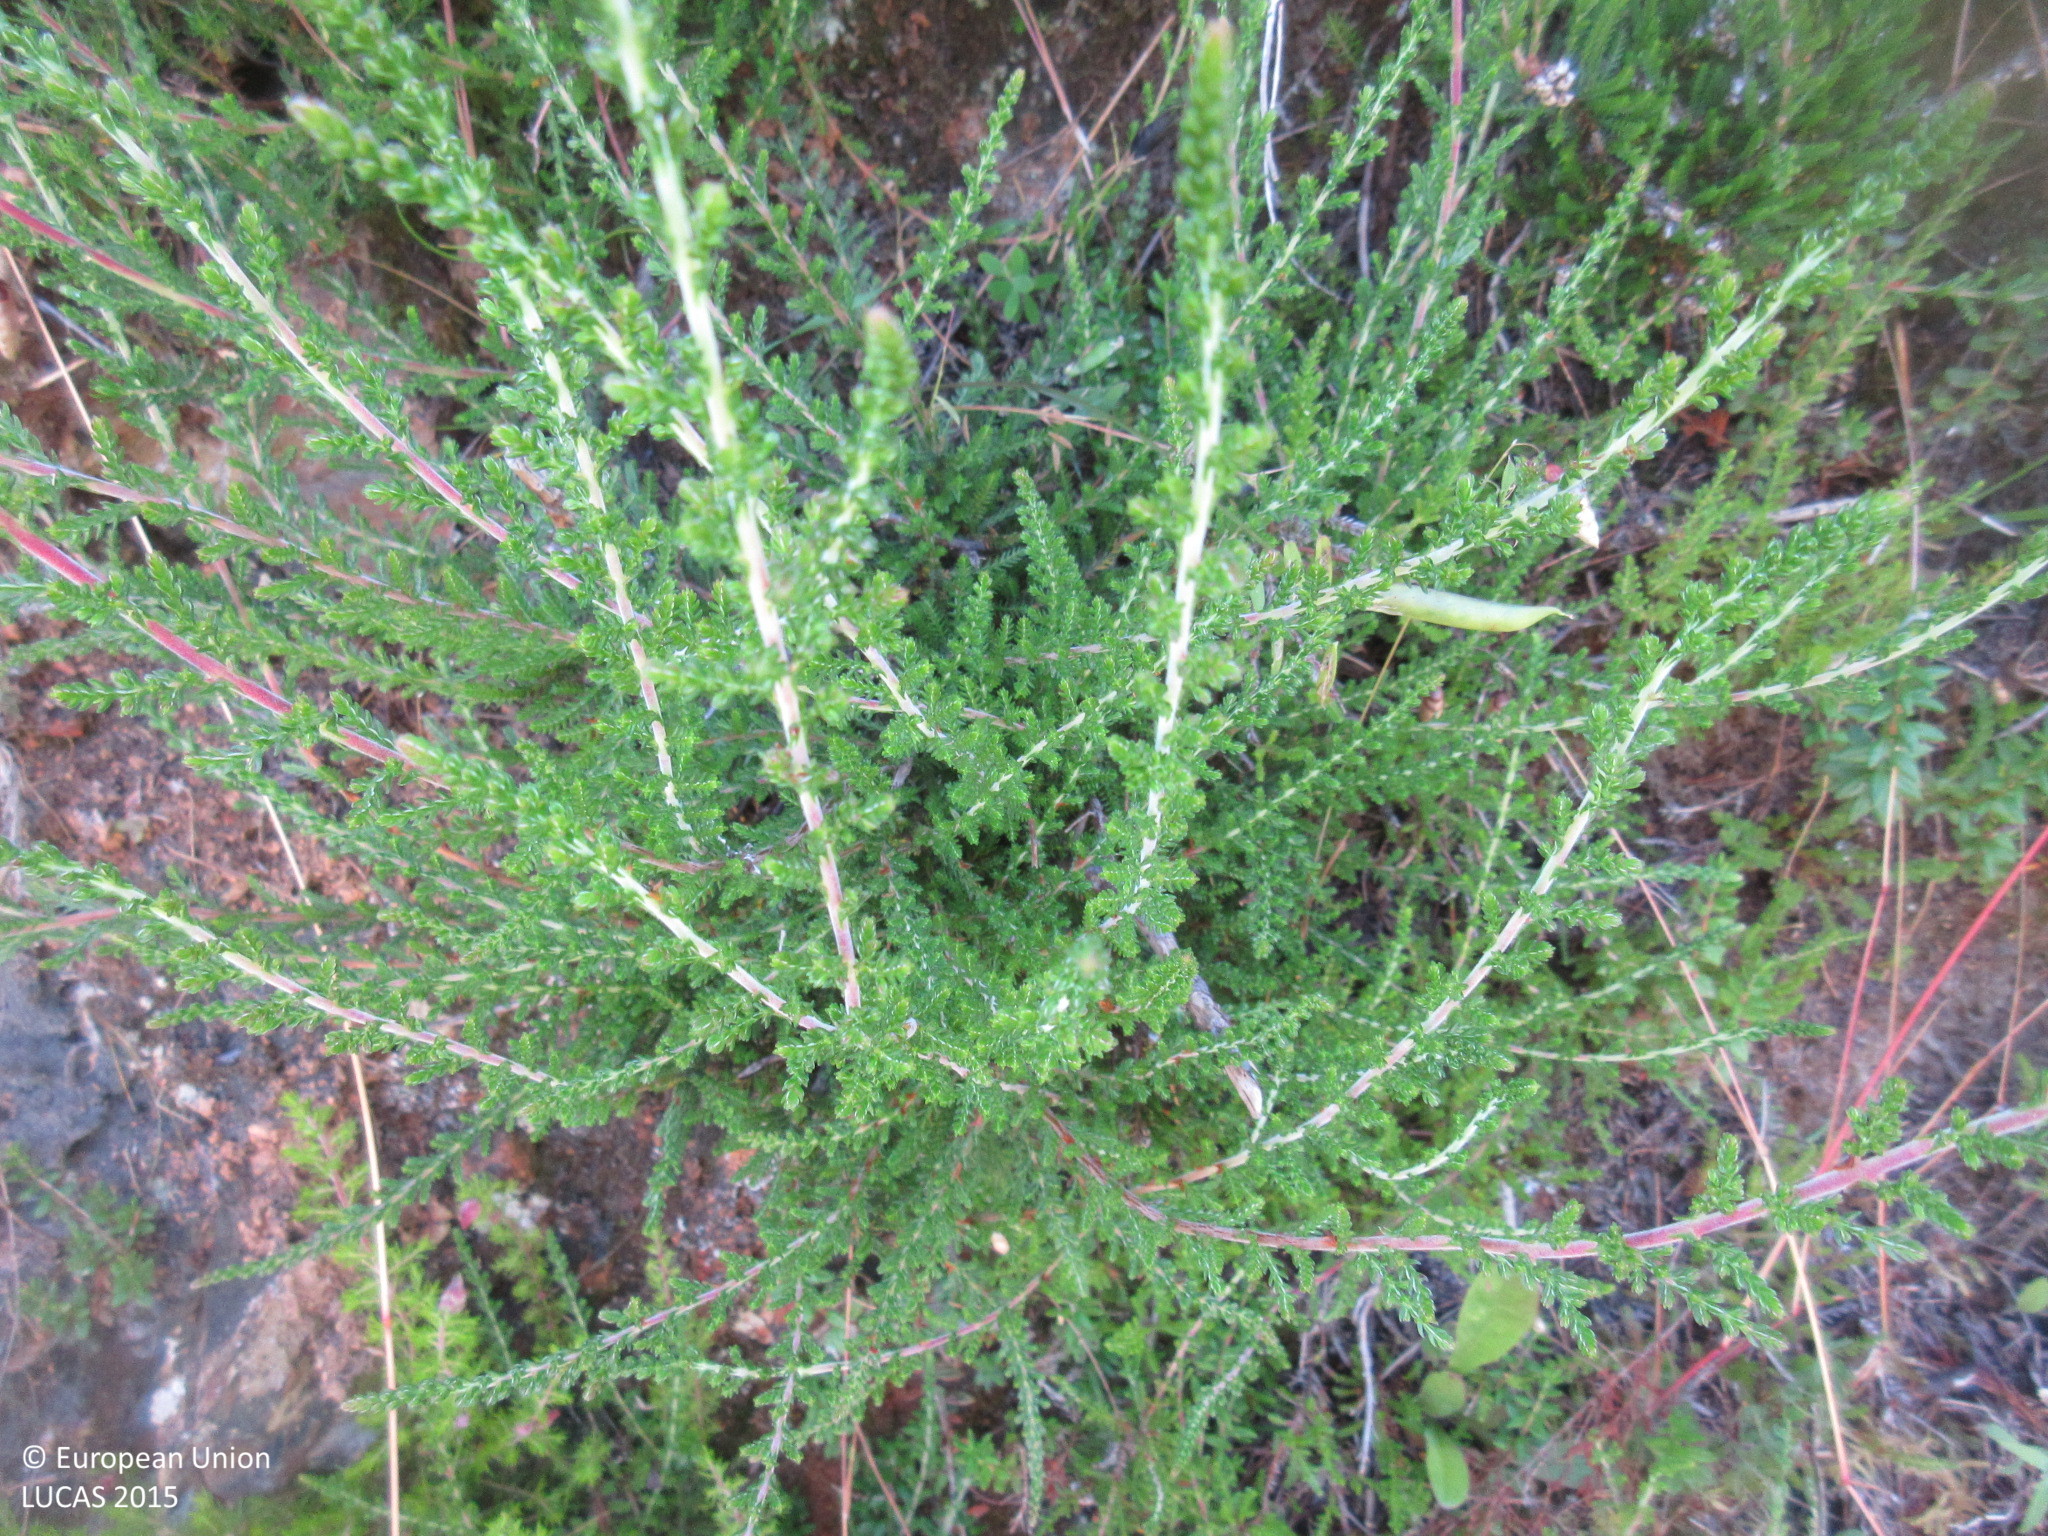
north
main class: Grassland
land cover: Grassland with sparse tree/shrub cover
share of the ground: > 75 %
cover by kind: herbaceous plants 95 %, broadleaved forest trees 5 %
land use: Agriculture (excluding fallow land and kitchen gardens)
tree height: < 5 m
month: June
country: ES
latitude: 43.2978
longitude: -7.1414
